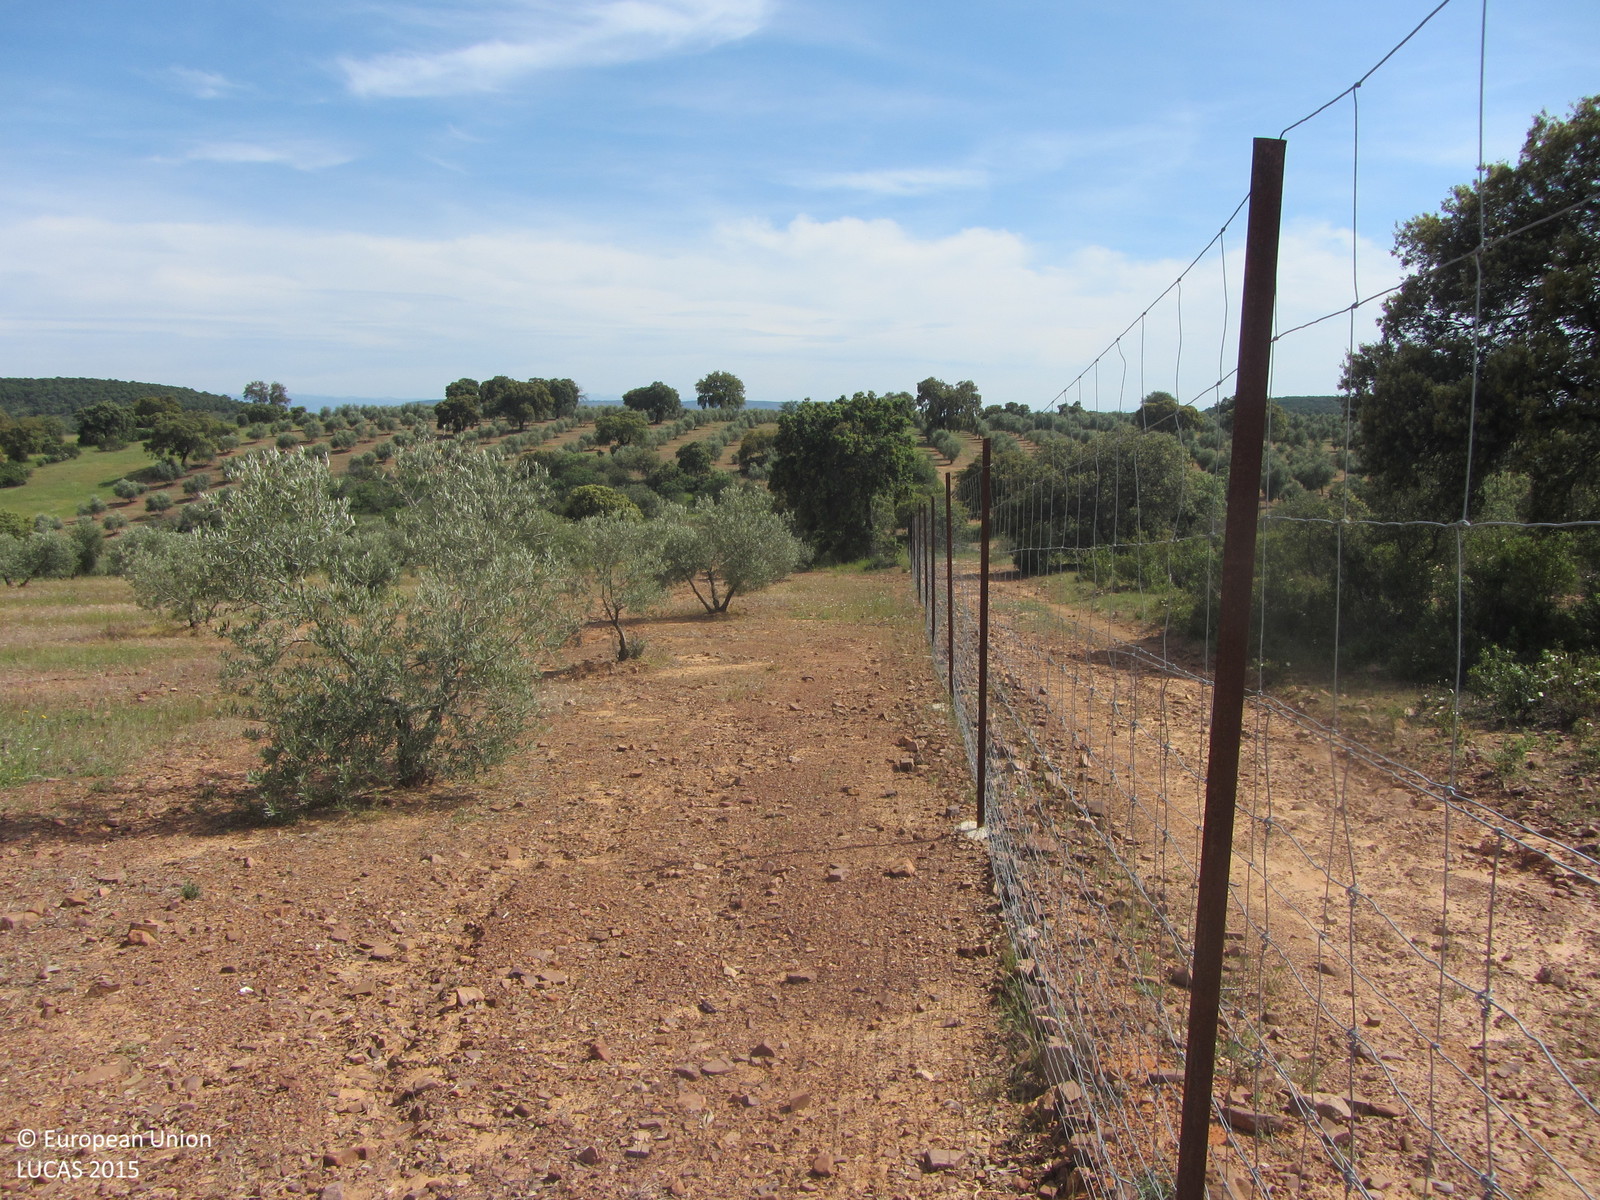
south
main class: Cropland
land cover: Olive groves
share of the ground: 10 - 25 %
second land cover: Spontaneously vegetated surfaces
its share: 50 - 75 %
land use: Agriculture (excluding fallow land and kitchen gardens)
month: May
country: ES
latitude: 38.4328
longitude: -3.0973
